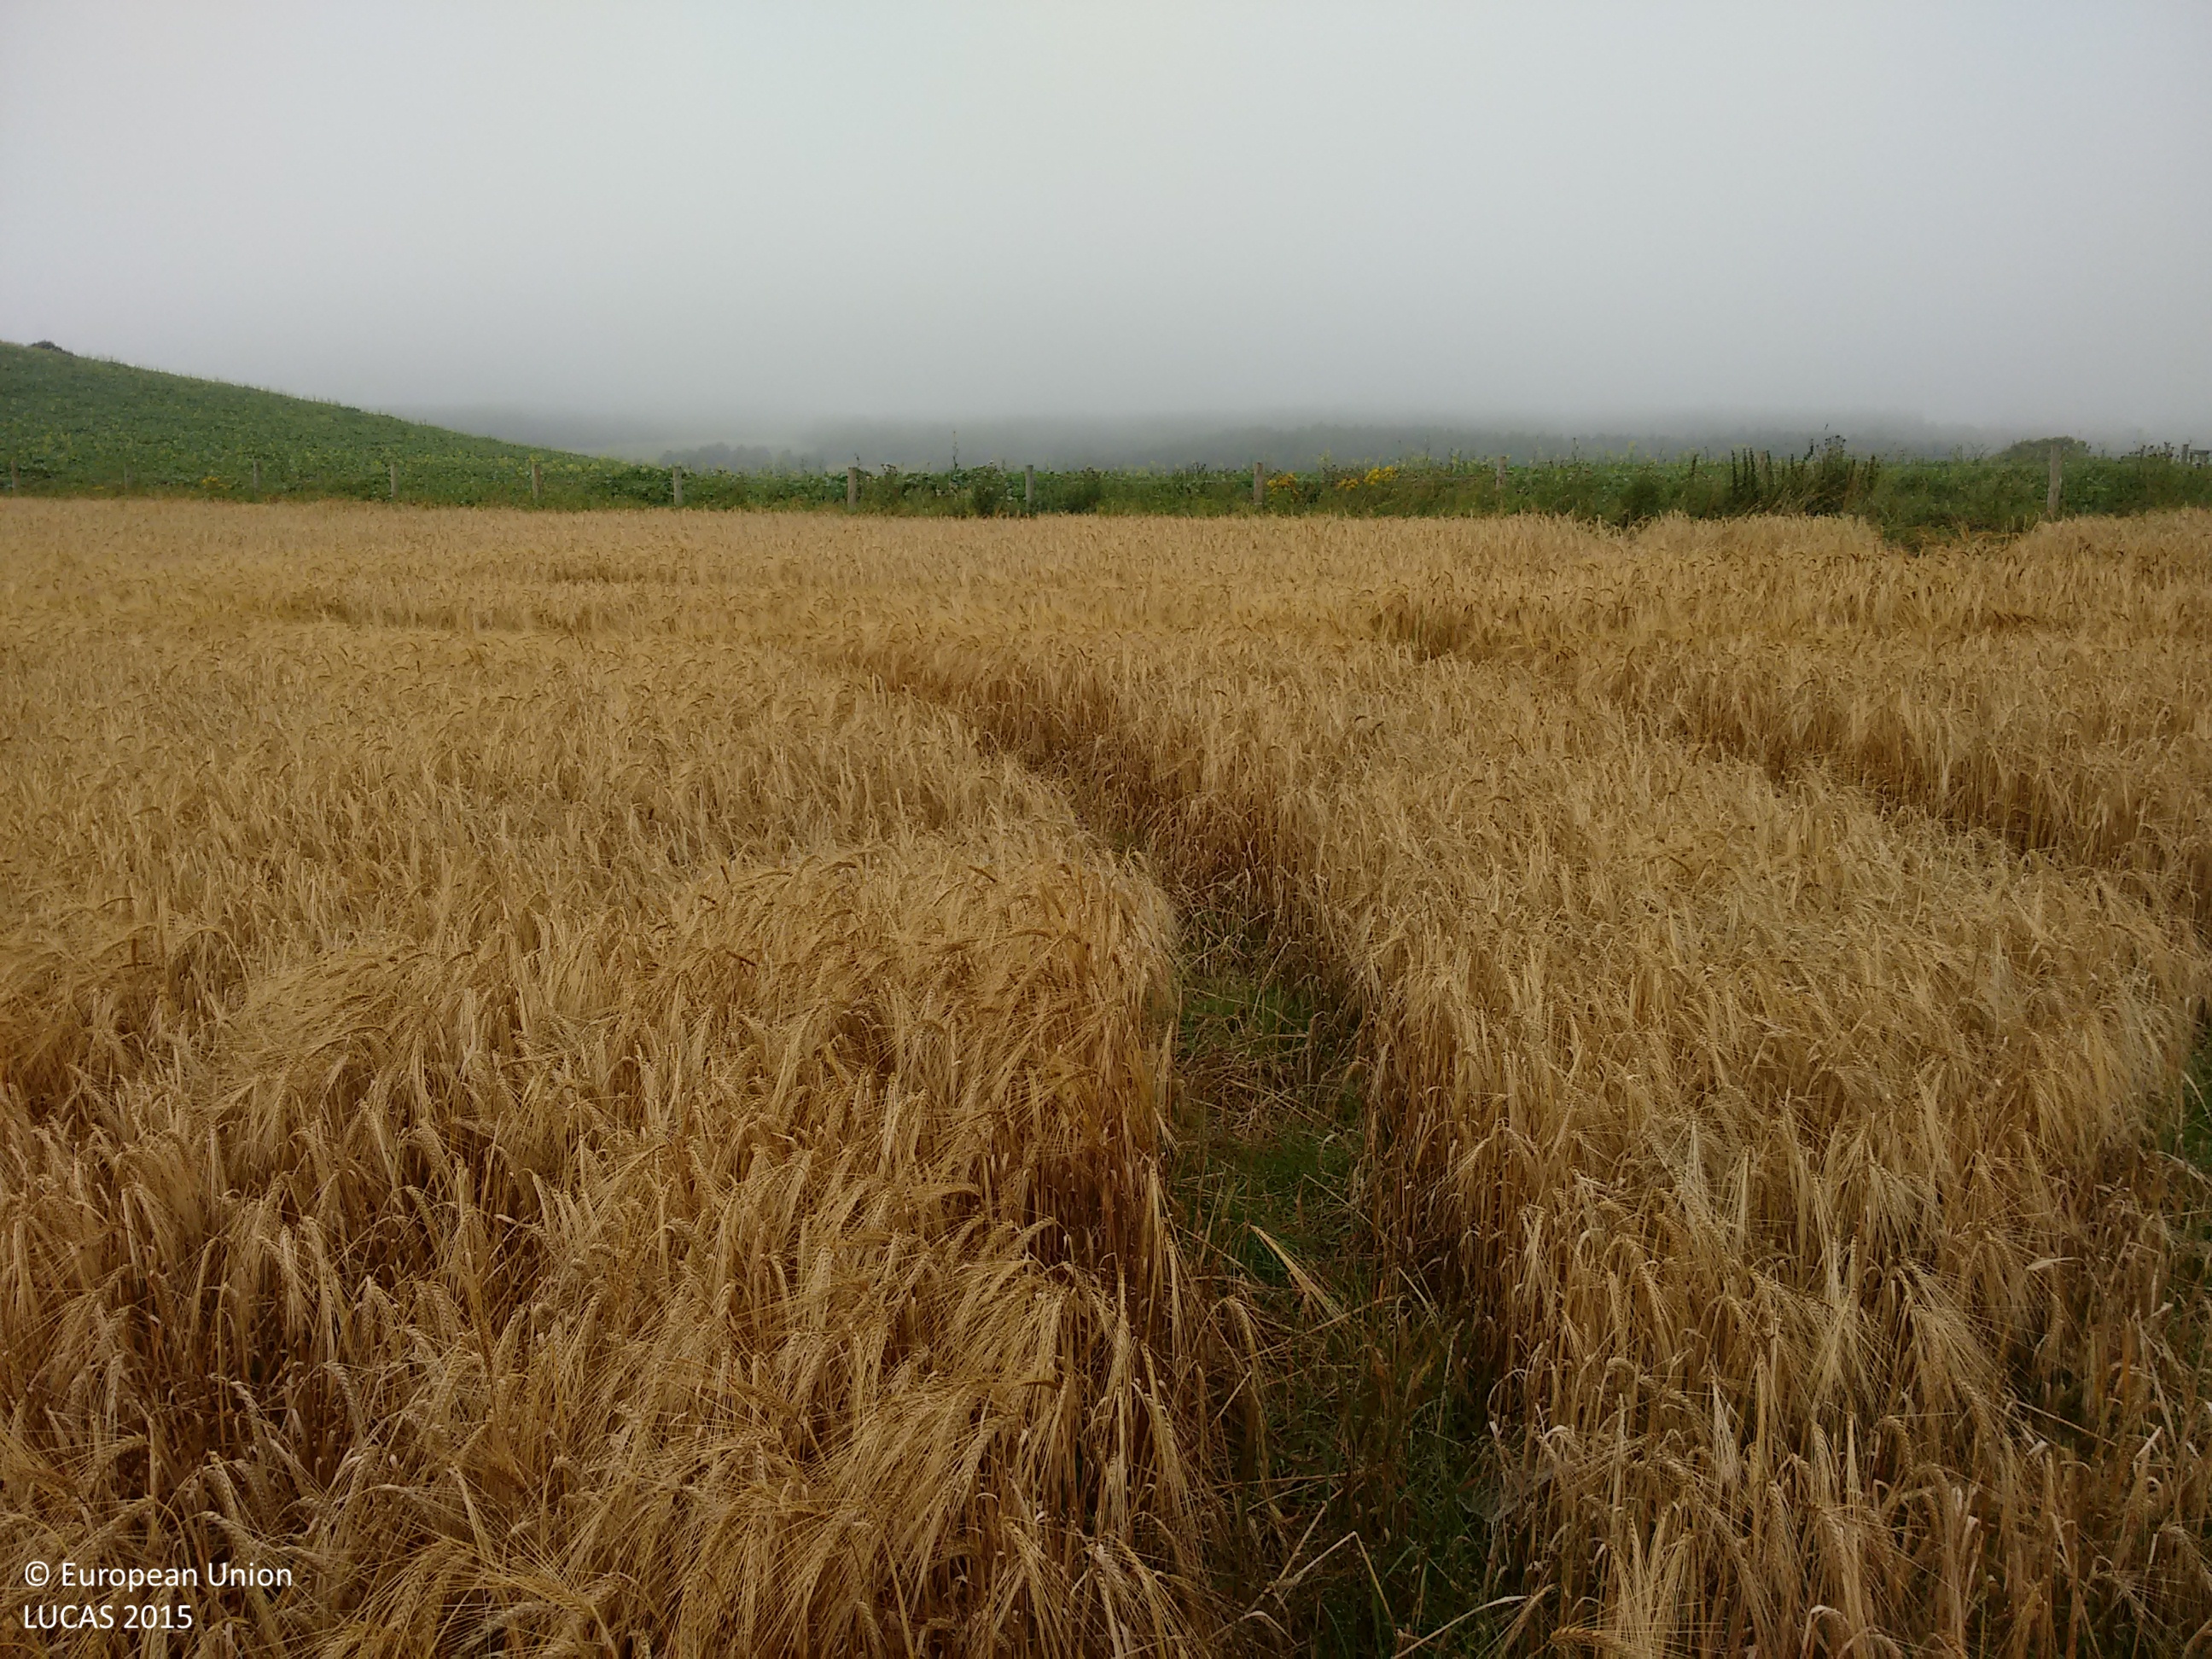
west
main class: Cropland
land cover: Barley
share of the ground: > 75 %
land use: Agriculture (excluding fallow land and kitchen gardens)
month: September
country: GB
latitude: 57.5193
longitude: -3.8173
